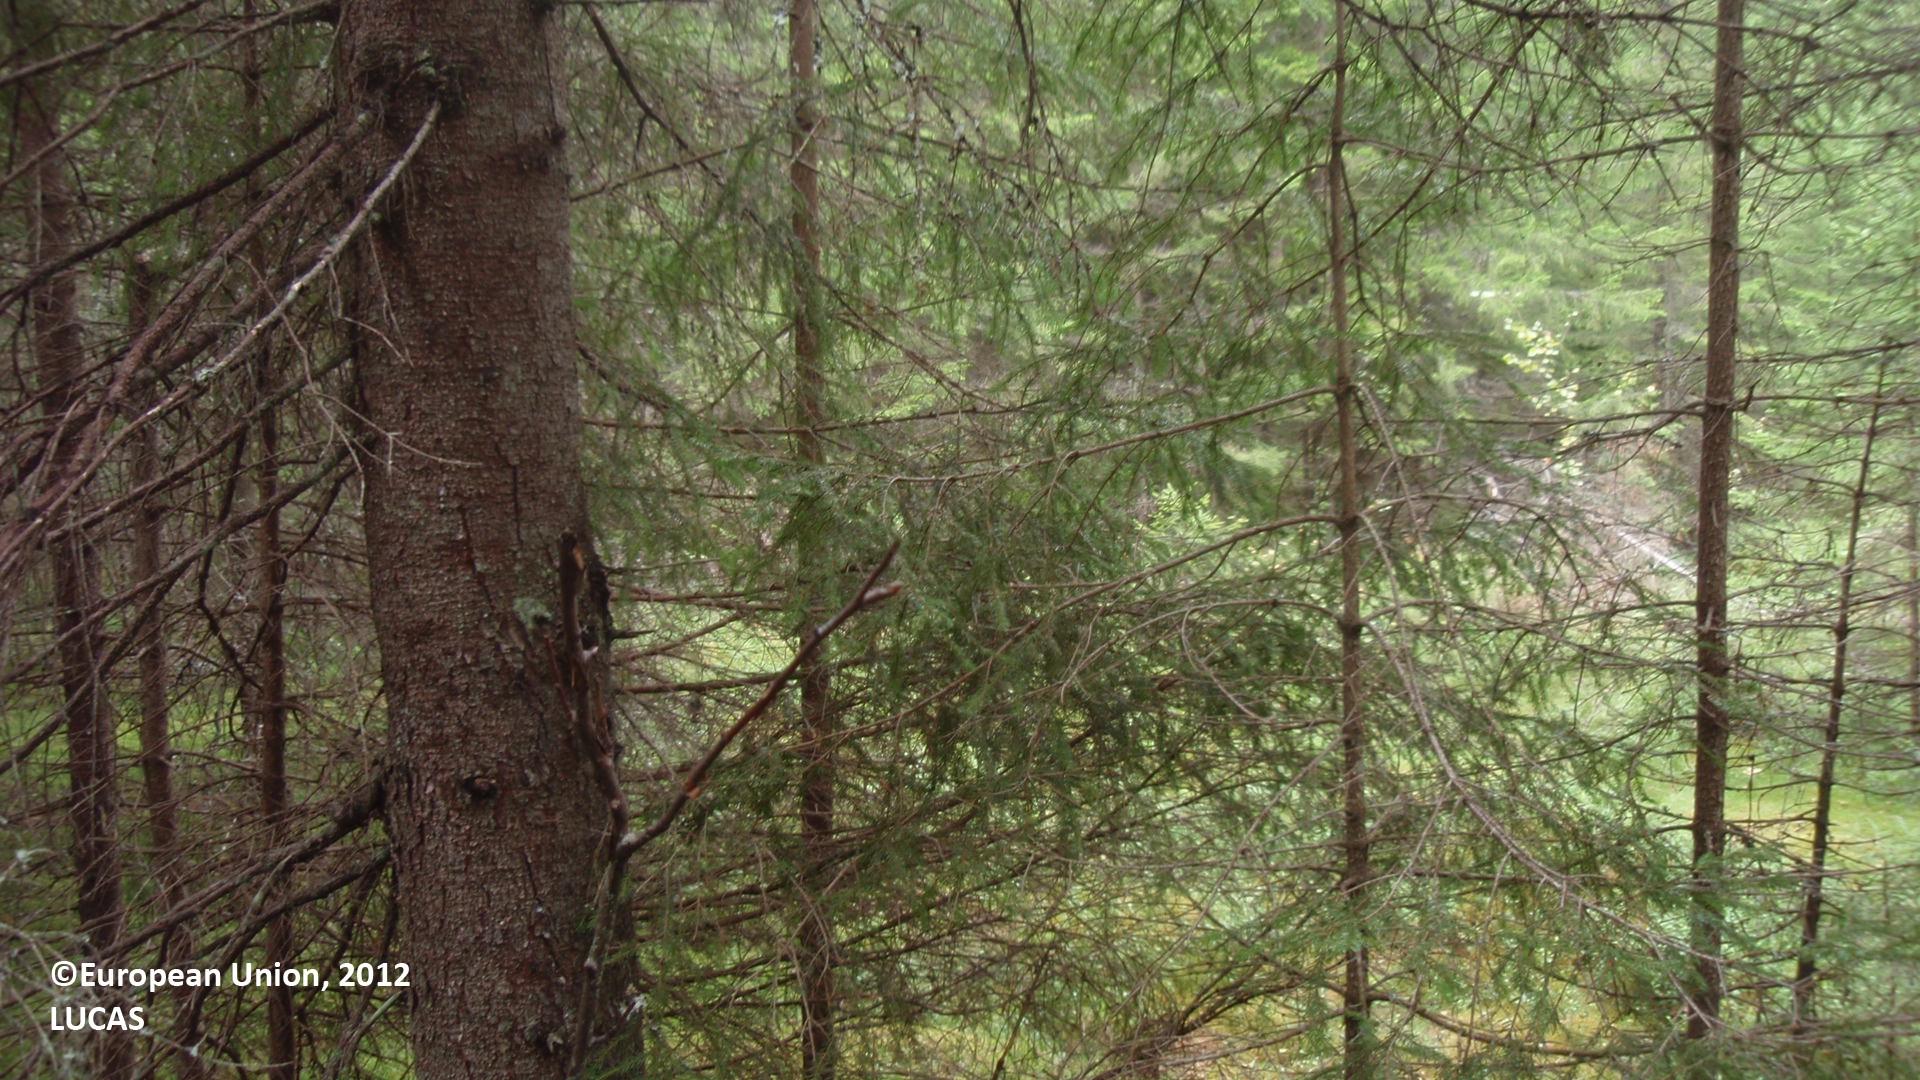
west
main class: Woodland
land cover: Spruce dominated coniferous woodland
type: boreal forest
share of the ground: 50 - 75 %
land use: Forestry
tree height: > 5 m
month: August
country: FI
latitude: 60.8160
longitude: 27.3313
